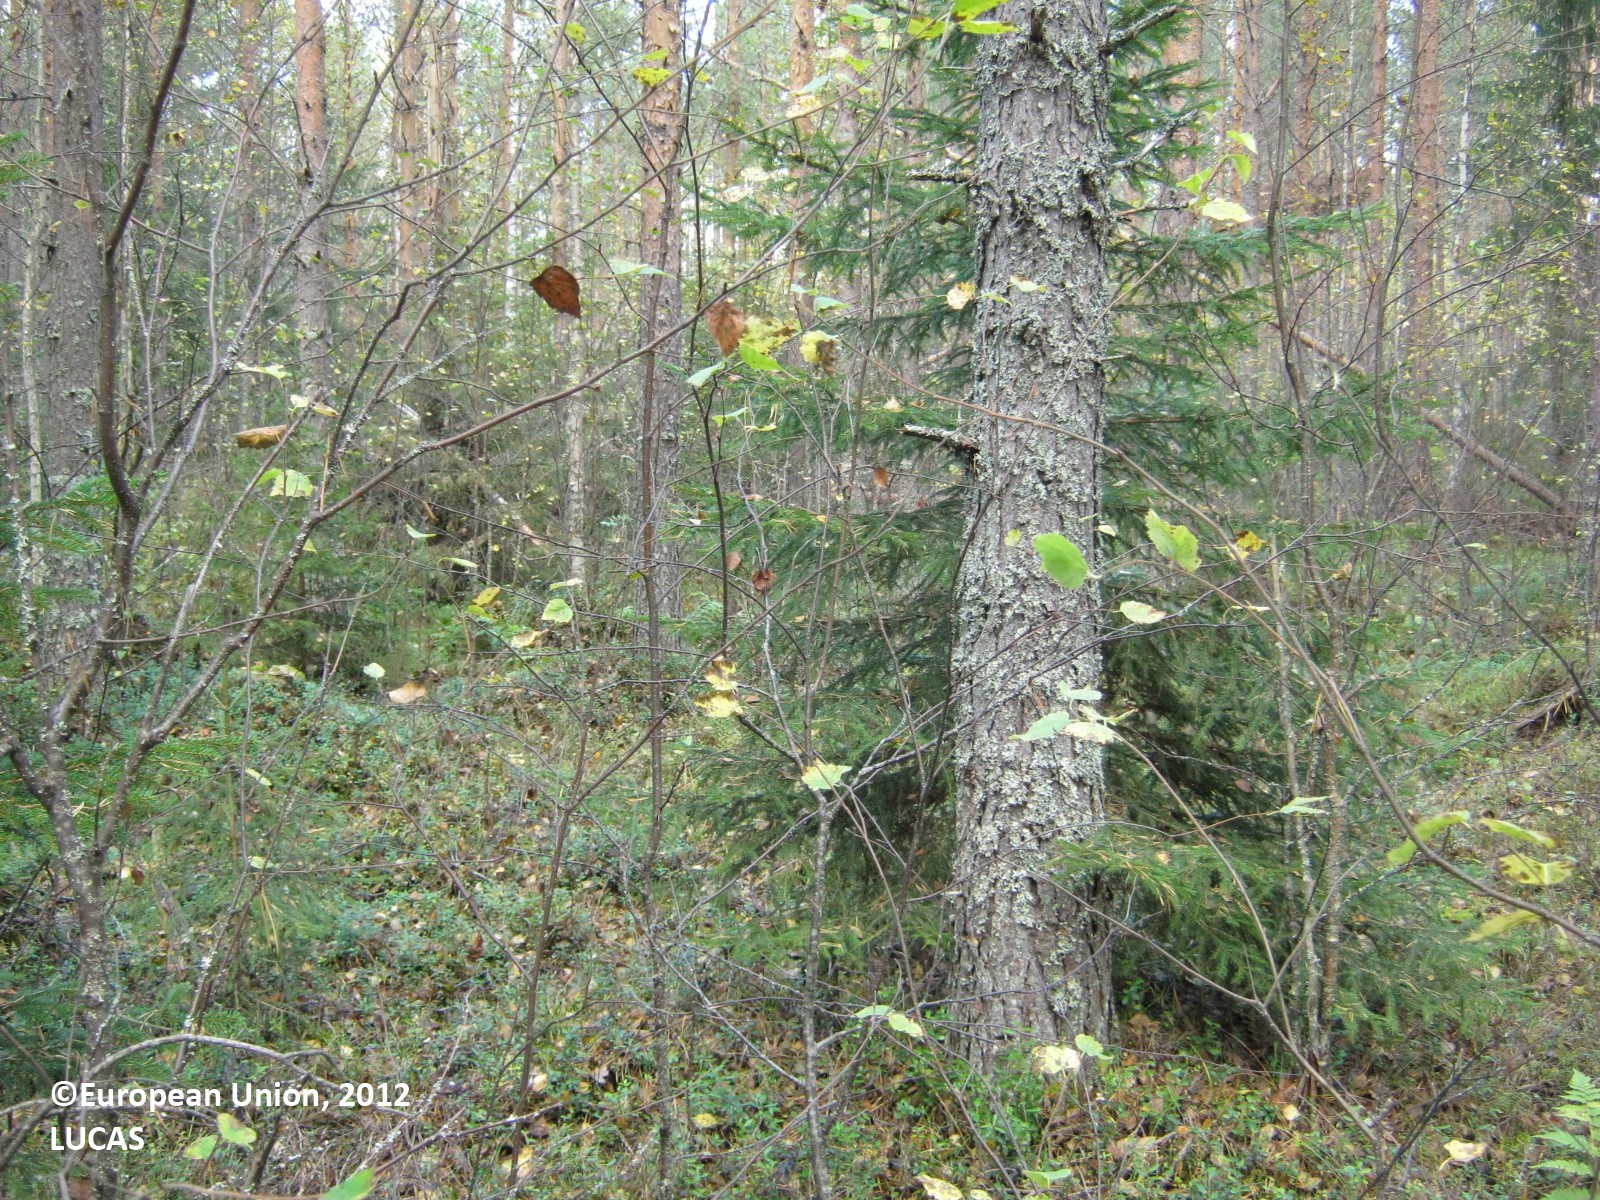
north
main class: Woodland
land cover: Pine dominated coniferous woodland
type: boreal forest
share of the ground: > 75 %
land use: Forestry
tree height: > 5 m
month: September
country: FI
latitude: 63.3545
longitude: 25.8404
